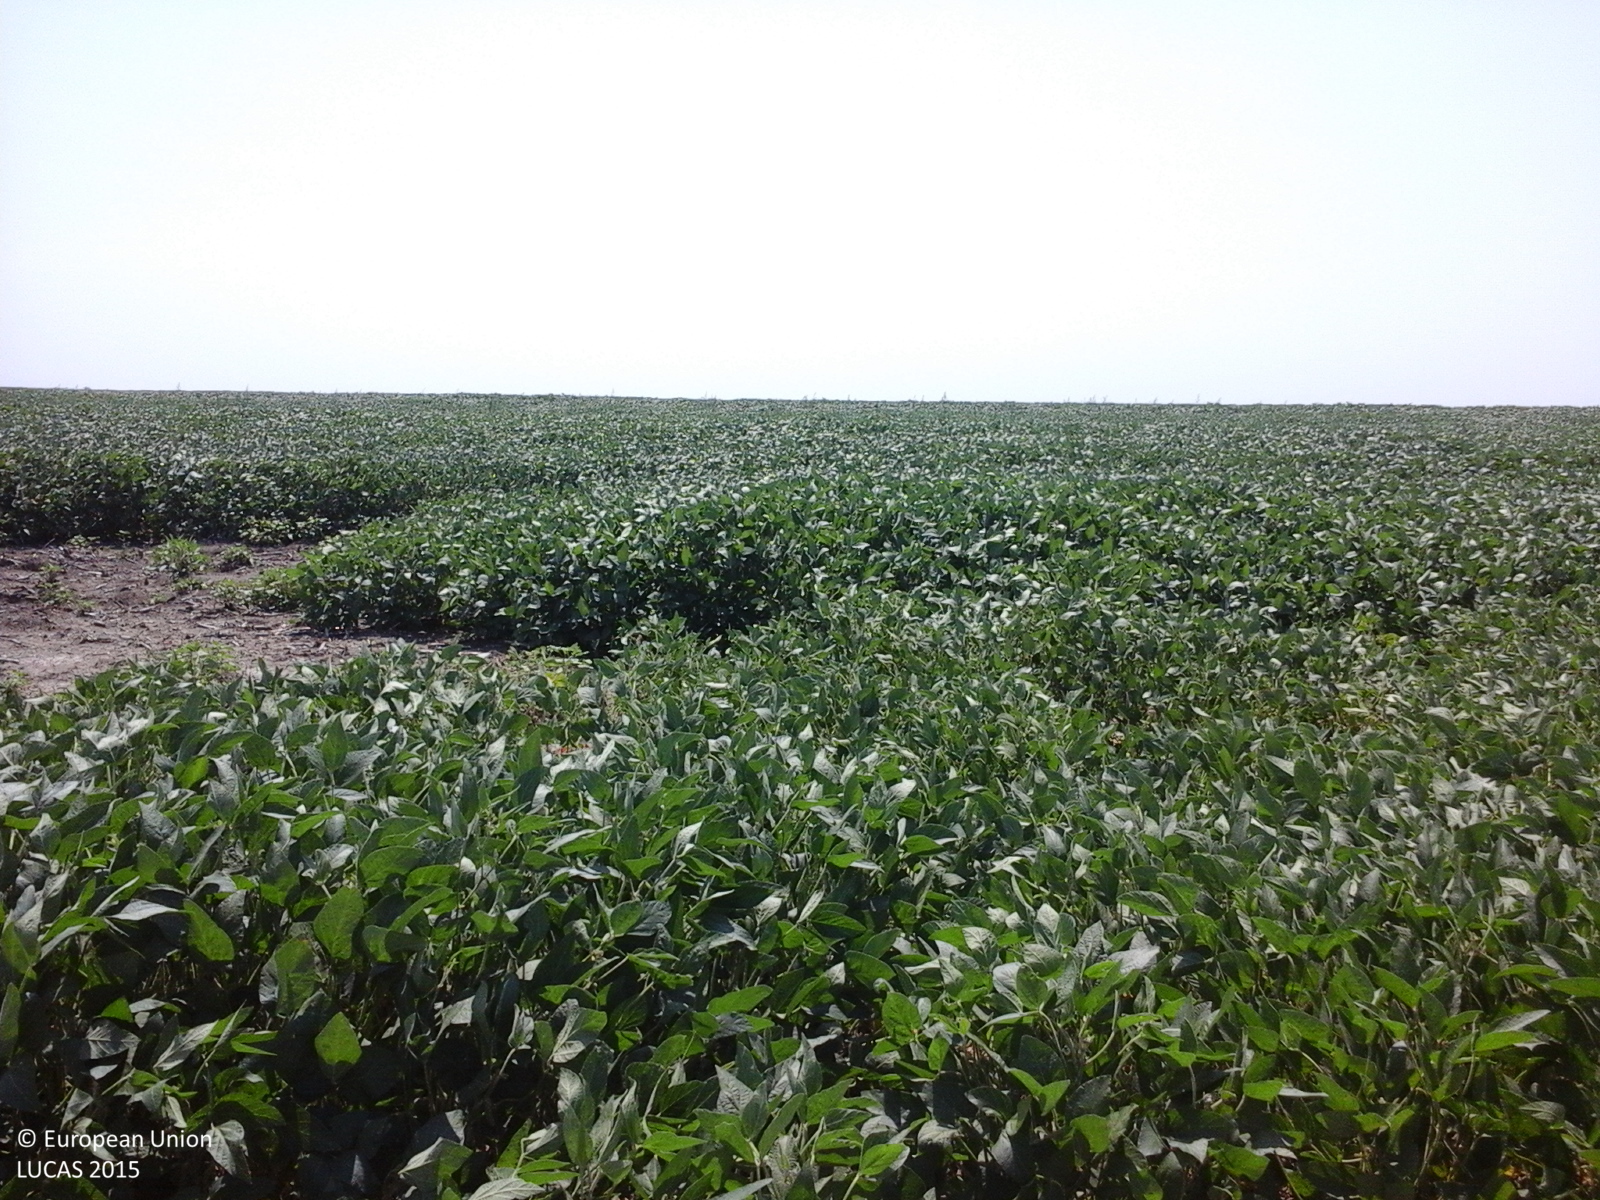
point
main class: Cropland
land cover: Soya
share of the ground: > 75 %
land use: Agriculture (excluding fallow land and kitchen gardens)
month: August
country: RO
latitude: 45.1036
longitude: 27.9950
